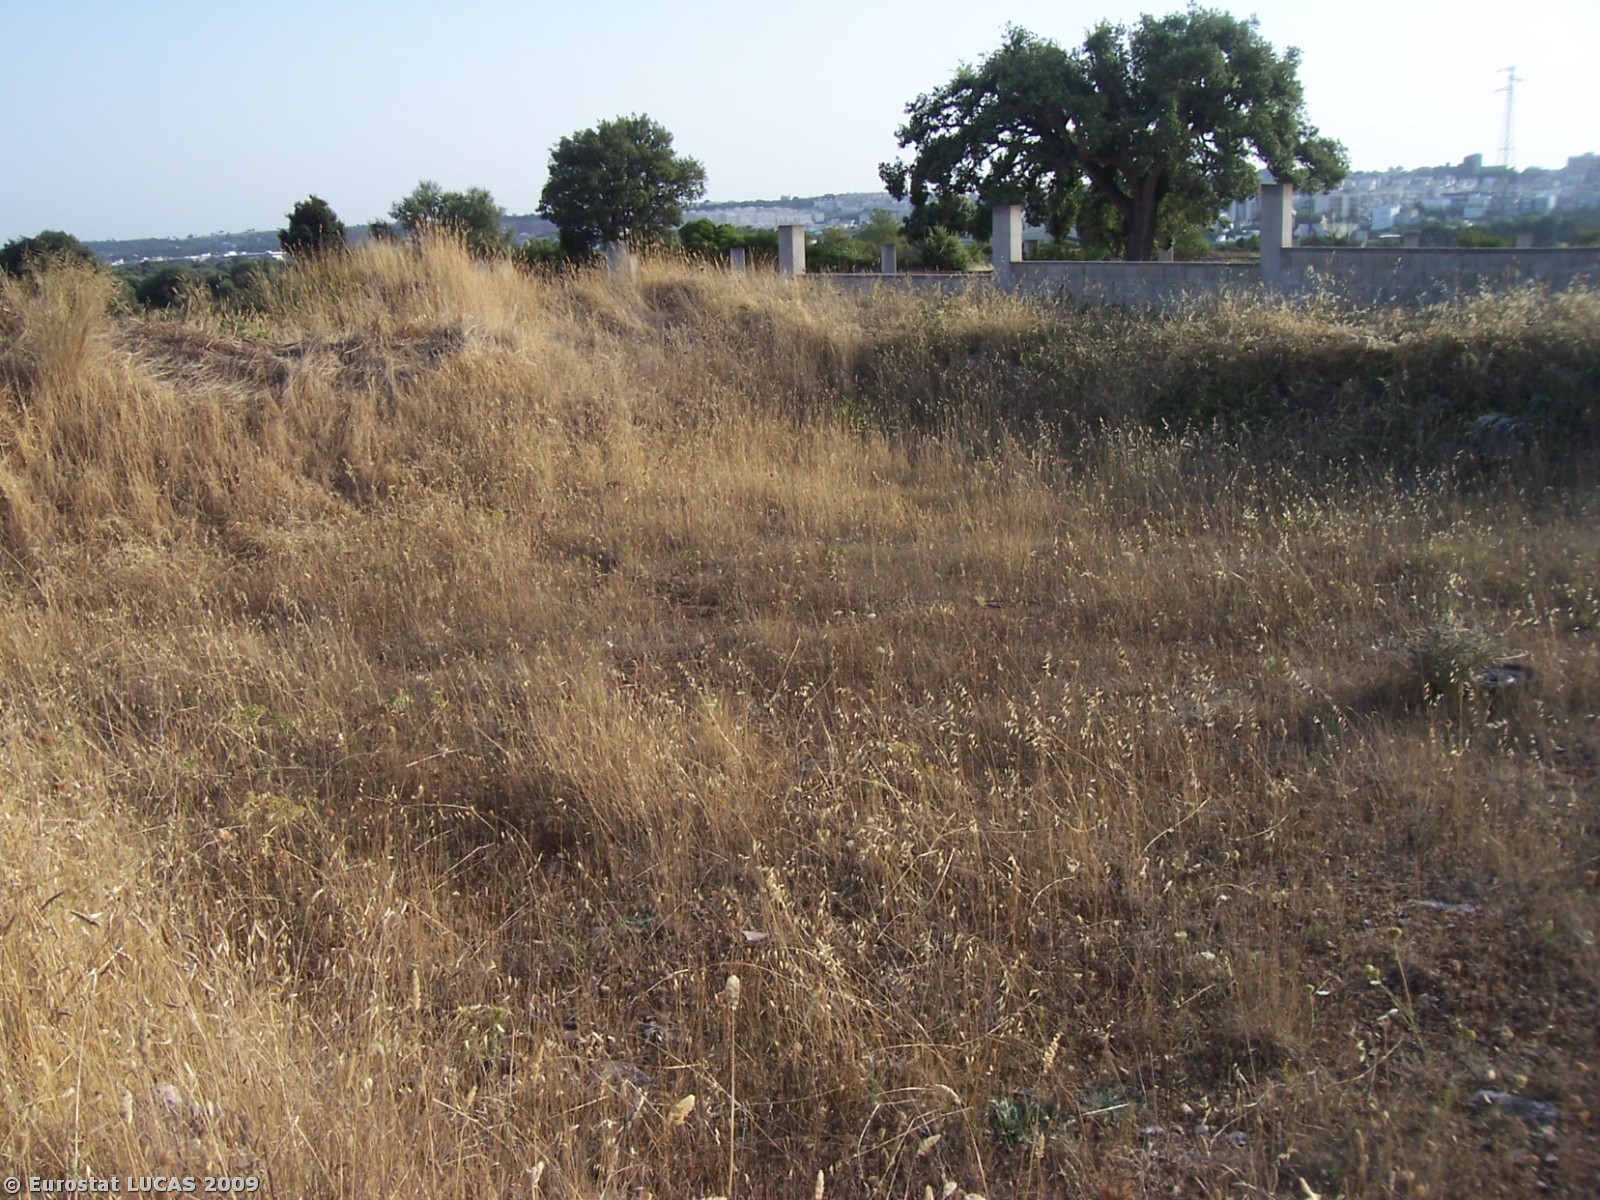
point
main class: Grassland
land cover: Spontaneously vegetated surfaces
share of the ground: > 75 %
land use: Fallow land
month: July
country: IT
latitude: 40.6494
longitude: 17.5336
